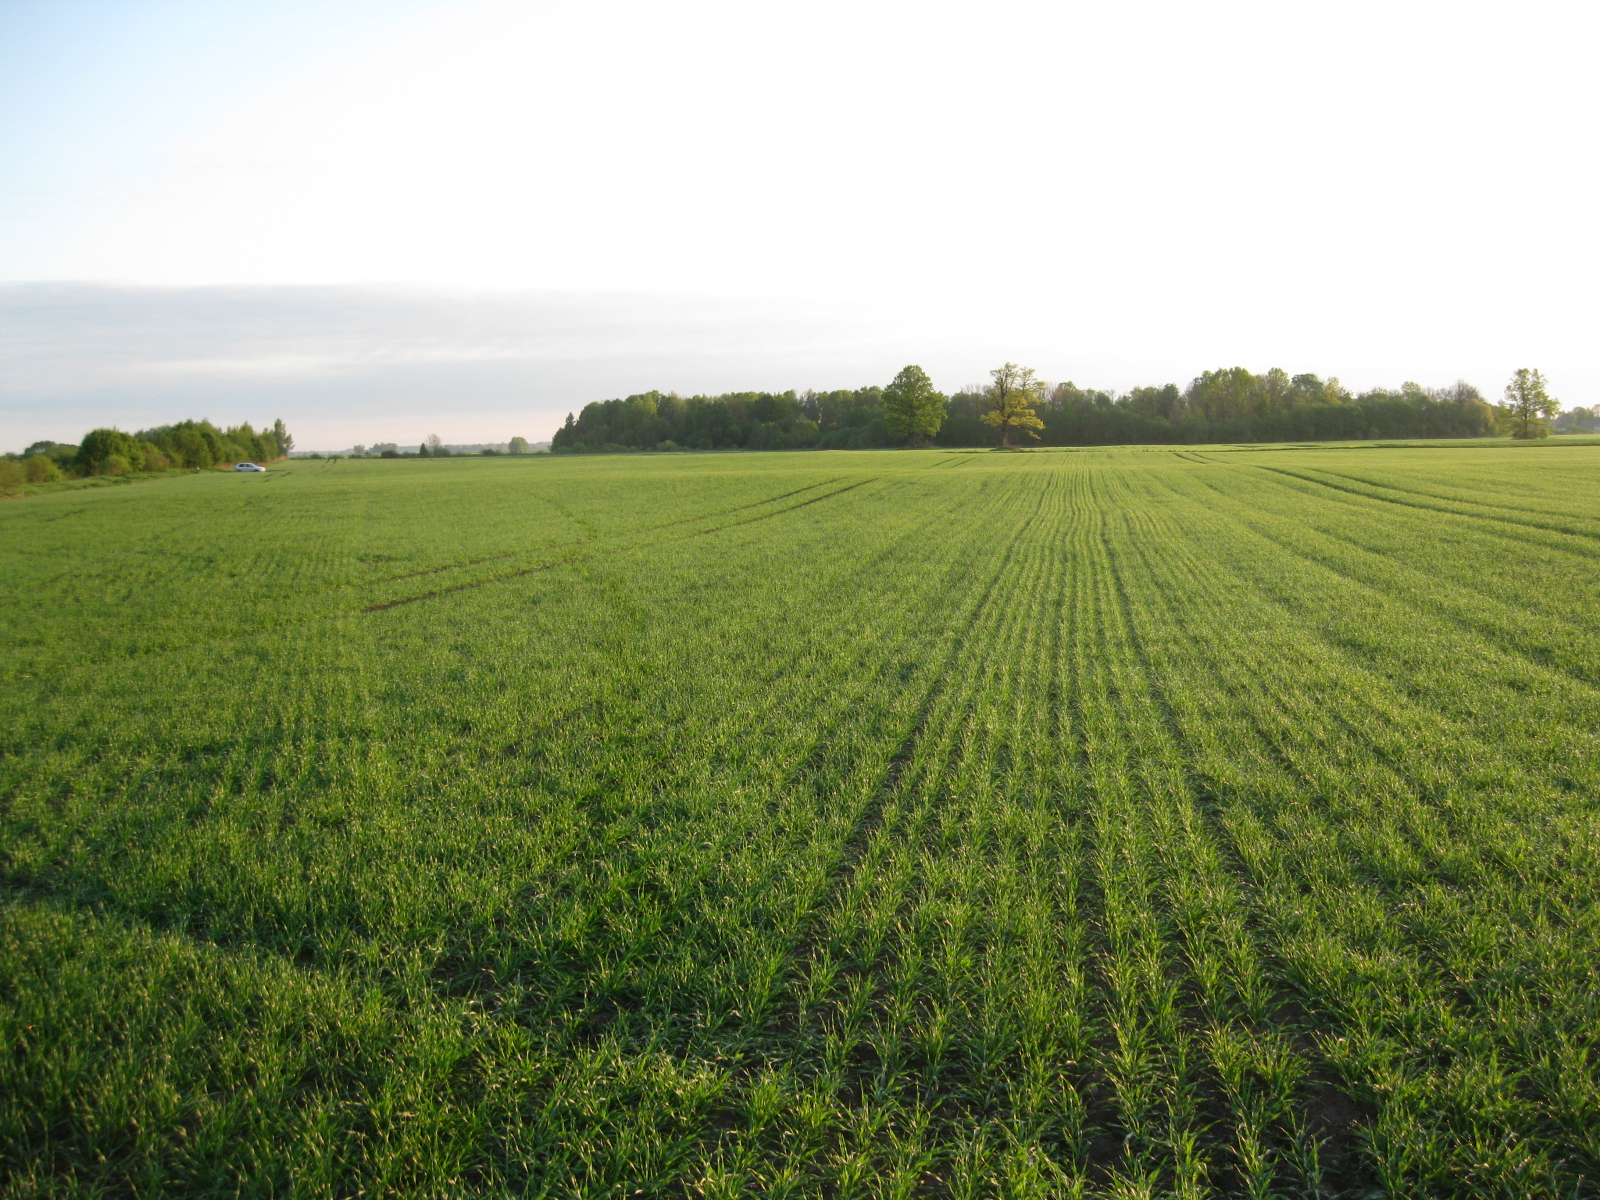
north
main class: Cropland
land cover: Barley
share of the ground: > 75 %
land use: Agriculture (excluding fallow land and kitchen gardens)
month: May
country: LT
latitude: 56.1133
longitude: 23.8005
